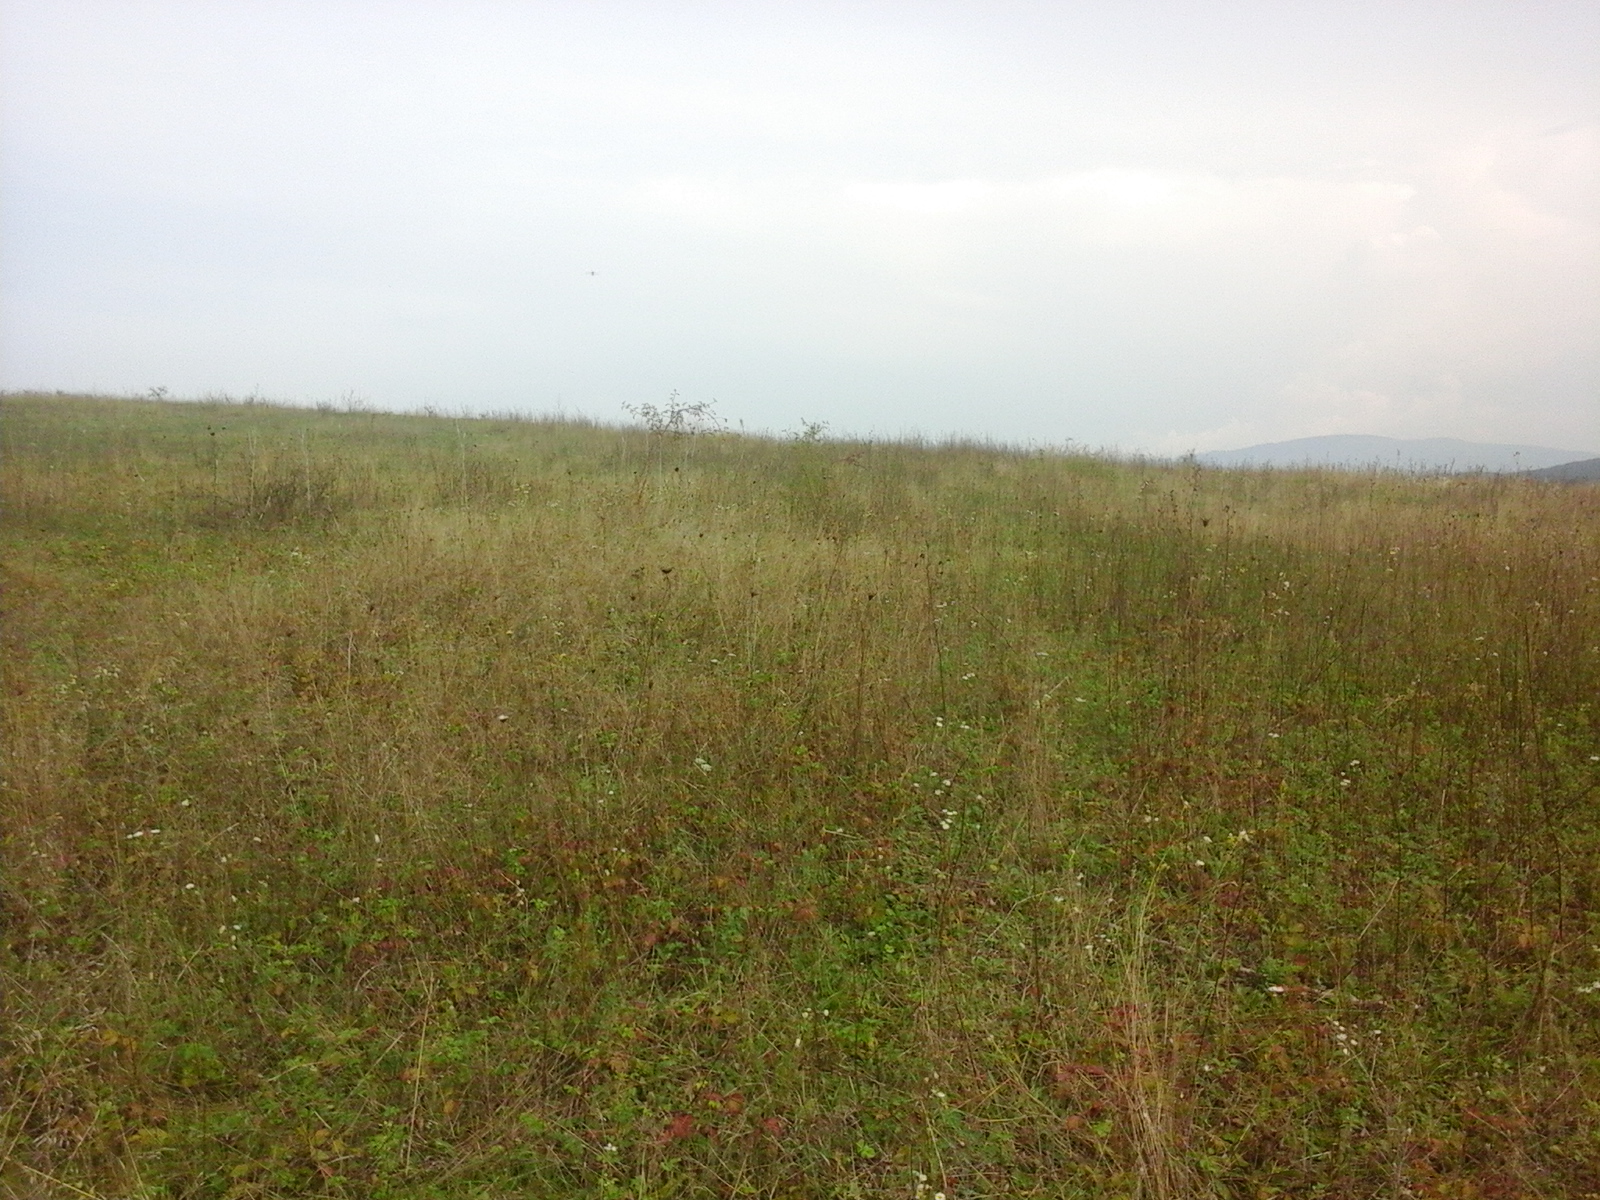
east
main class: Grassland
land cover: Spontaneously vegetated surfaces
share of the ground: > 75 %
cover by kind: herbaceous plants 100 %
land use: Agriculture (excluding fallow land and kitchen gardens)
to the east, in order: Spontaneously vegetated surfaces; Tracks; Grass margins; Maize
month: September
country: RO
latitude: 45.7513
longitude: 23.0256
